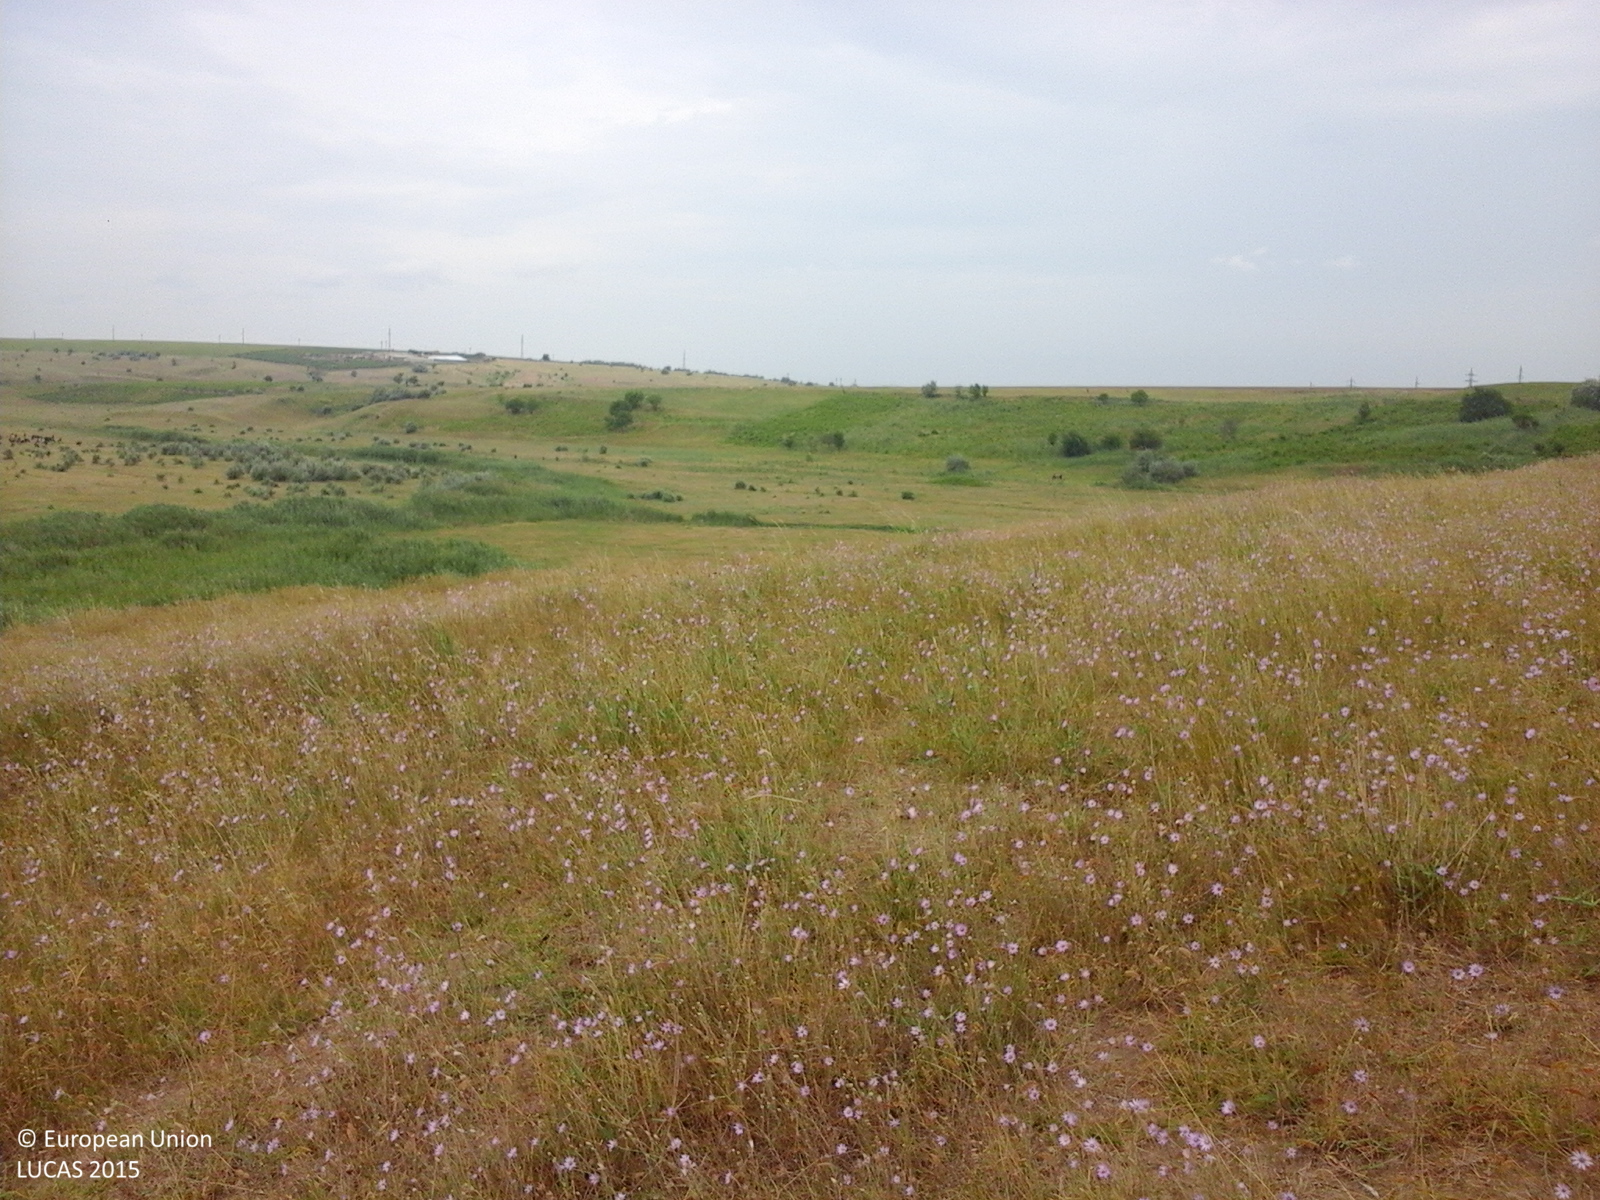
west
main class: Grassland
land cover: Grassland without tree/shrub cover
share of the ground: > 75 %
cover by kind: herbaceous plants 100 %
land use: Agriculture (excluding fallow land and kitchen gardens)
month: August
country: RO
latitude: 44.9078
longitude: 28.1655
